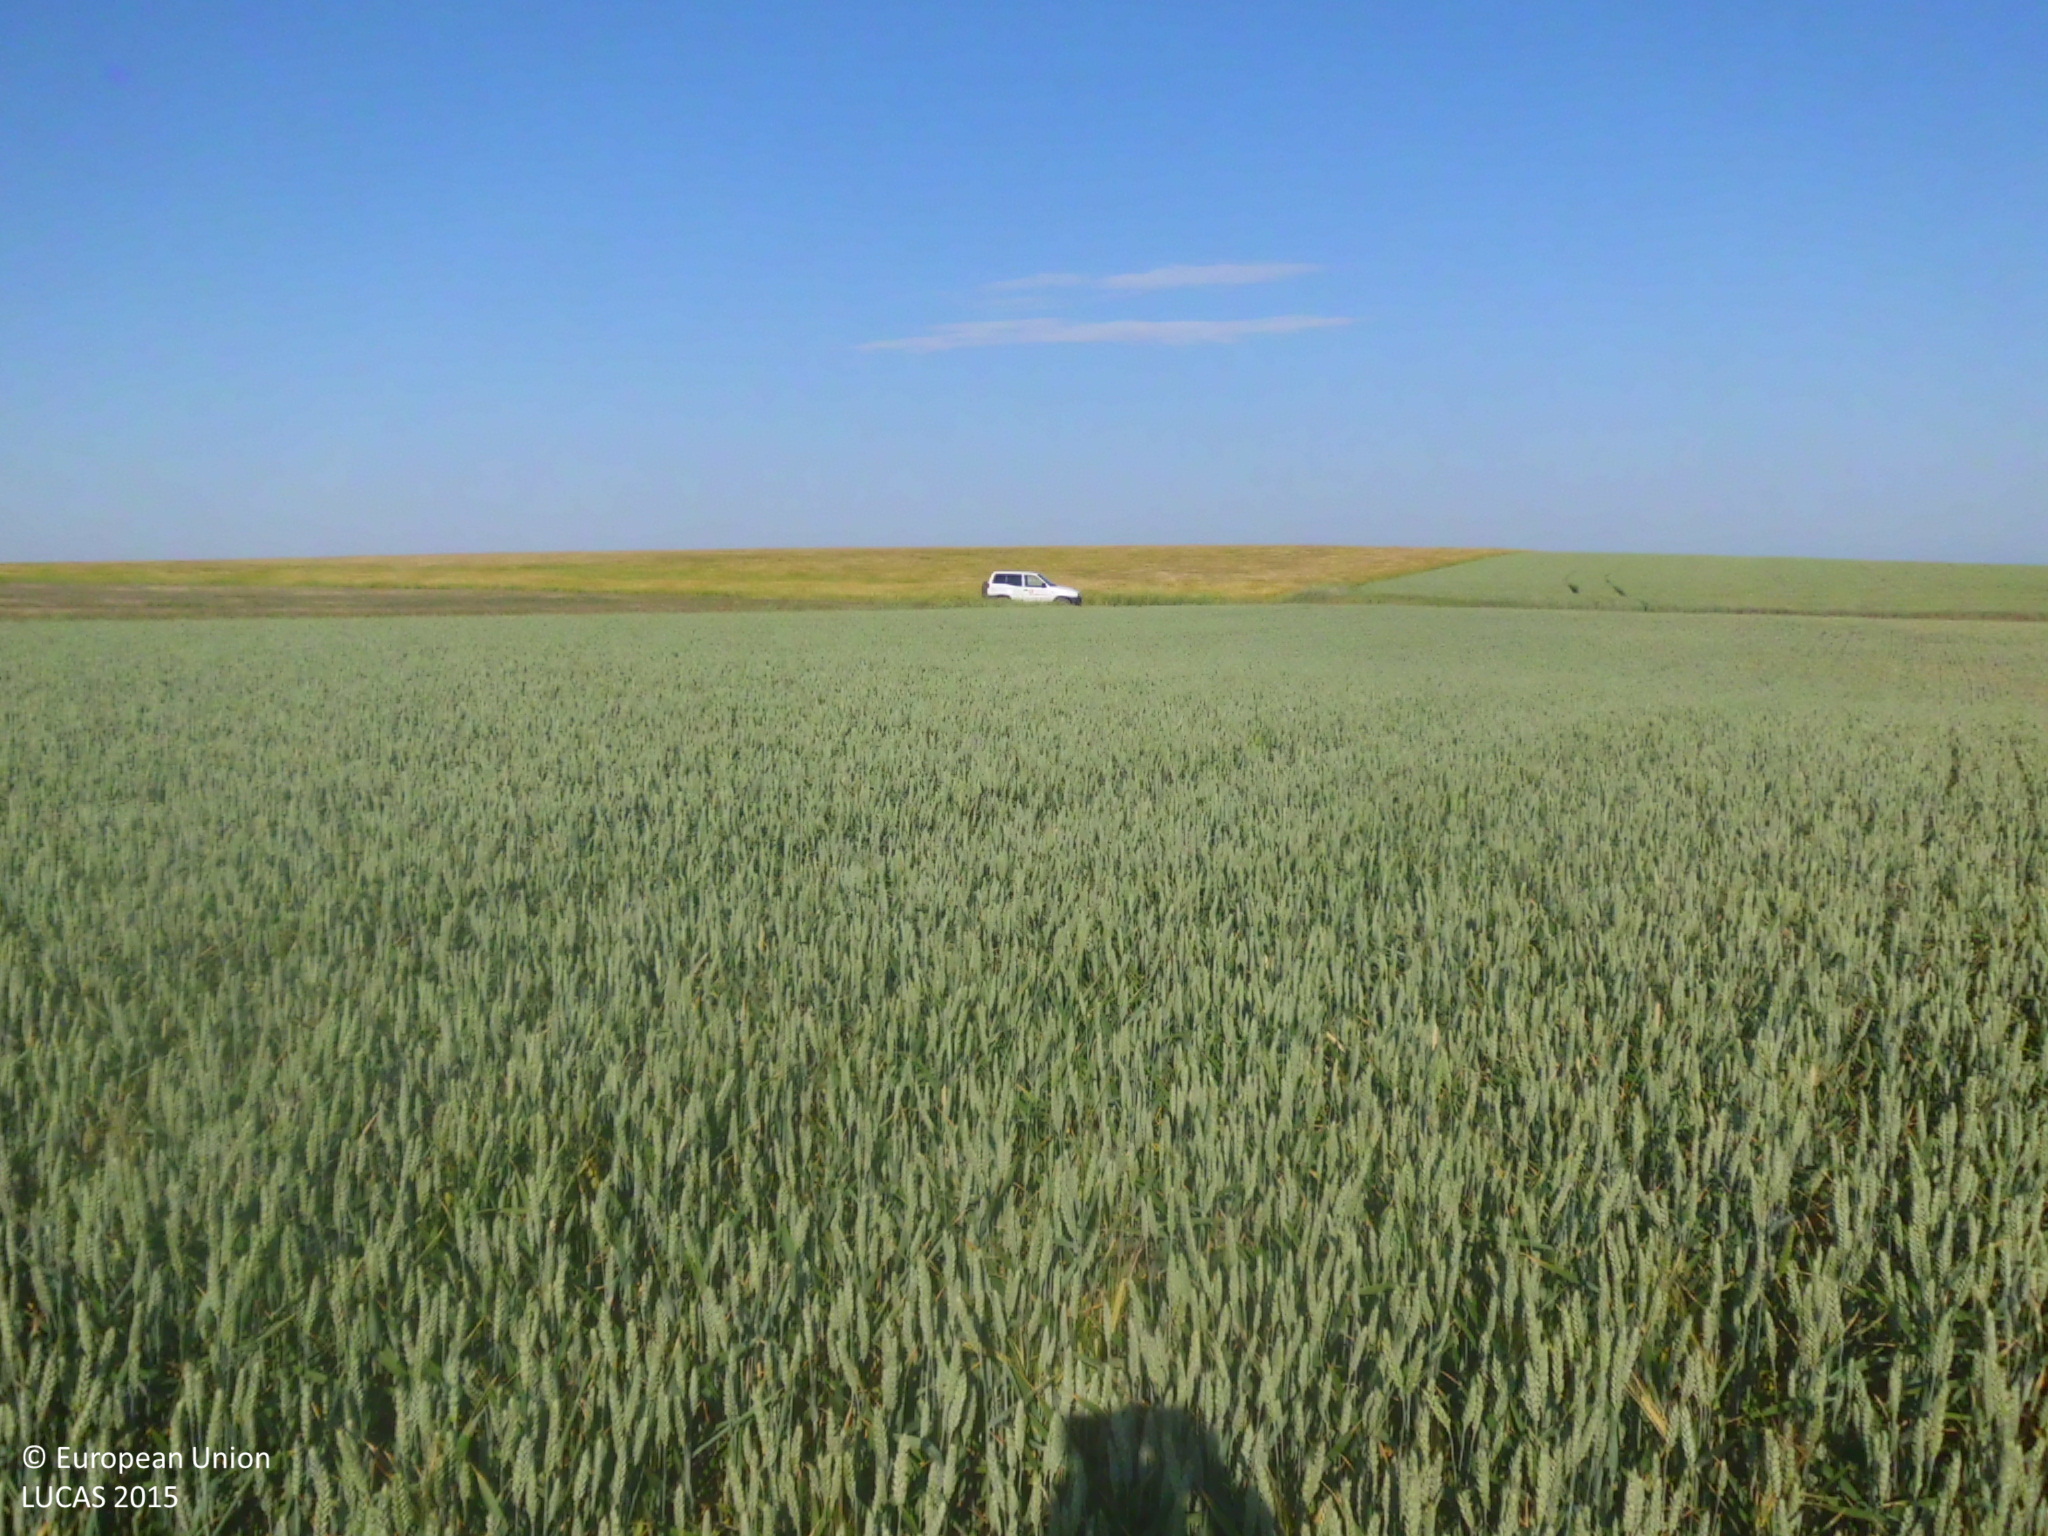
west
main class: Cropland
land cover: Common wheat
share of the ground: > 75 %
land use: Agriculture (excluding fallow land and kitchen gardens)
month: June
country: ES
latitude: 42.4644
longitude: -3.9915
